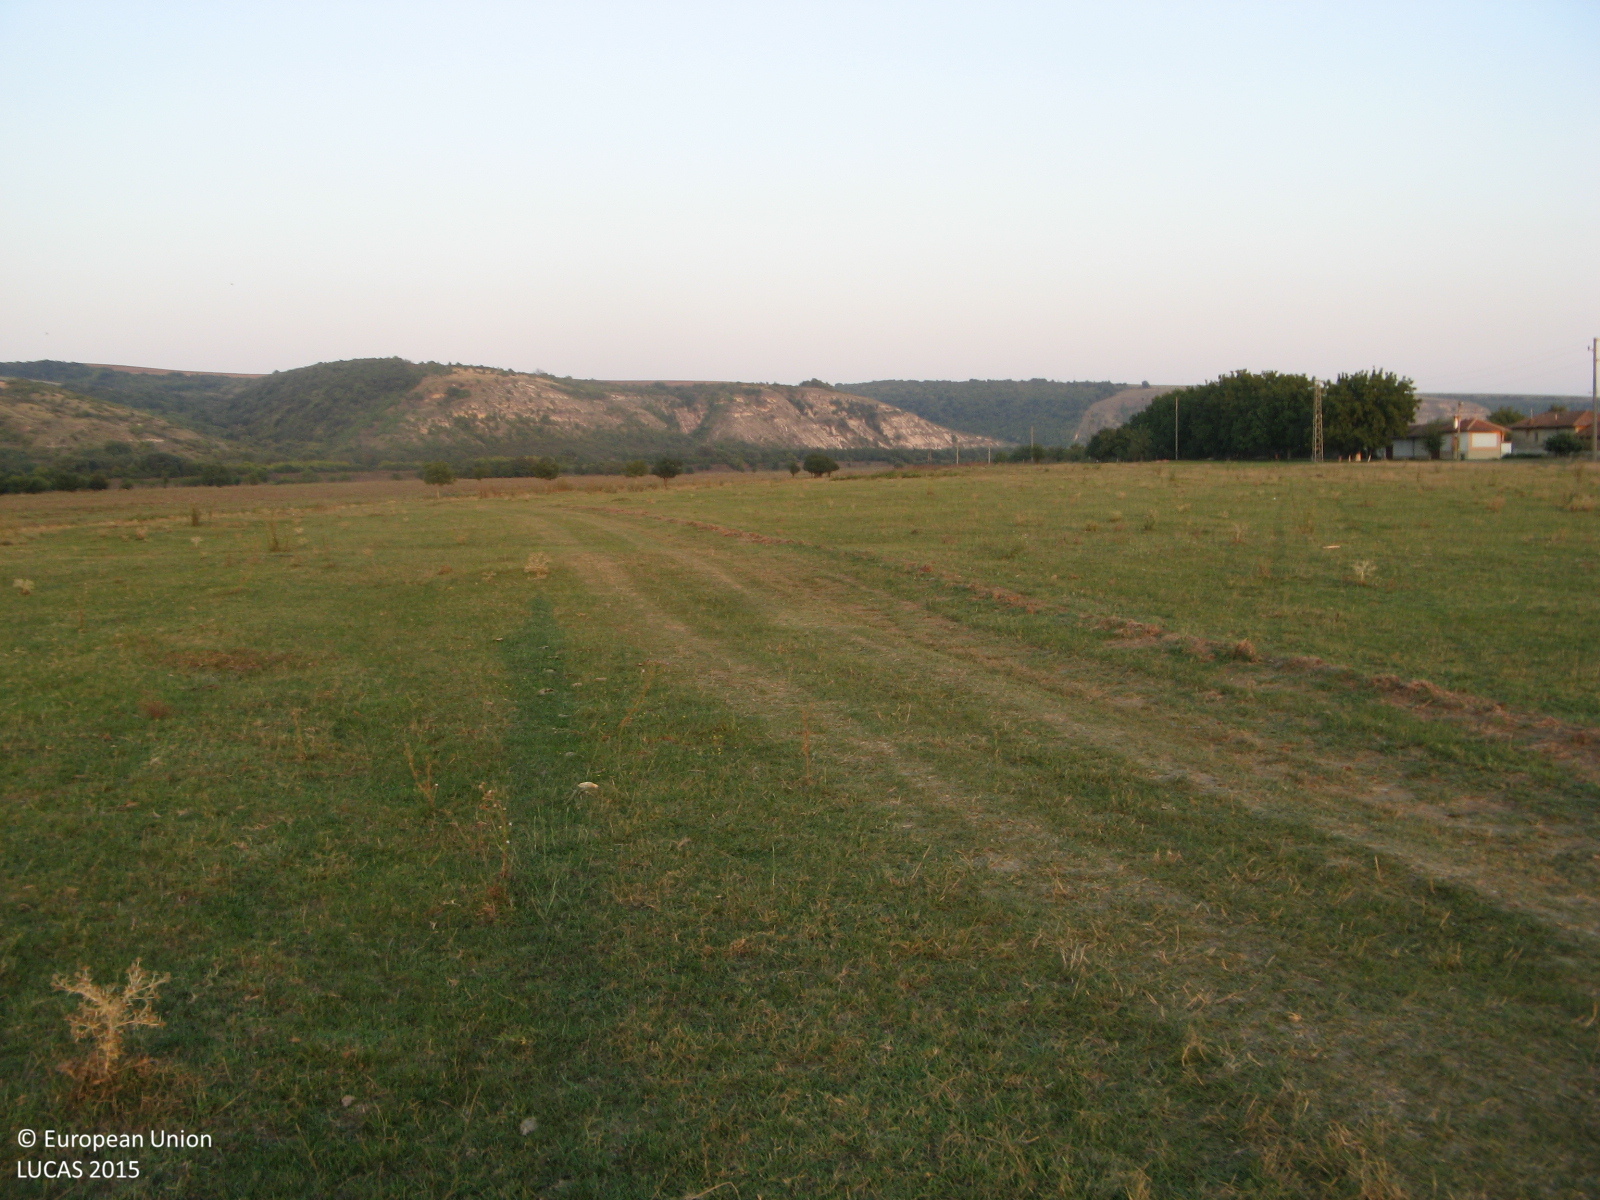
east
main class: Grassland
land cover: Grassland without tree/shrub cover
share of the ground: > 75 %
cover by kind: herbaceous plants 100 %
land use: Agriculture (excluding fallow land and kitchen gardens)
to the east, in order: Grassland without tree/shrub cover; Tracks; Grassland without tree/shrub cover; Tracks; Grassland without tree/shrub cover
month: September
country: BG
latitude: 43.5334
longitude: 25.6900
